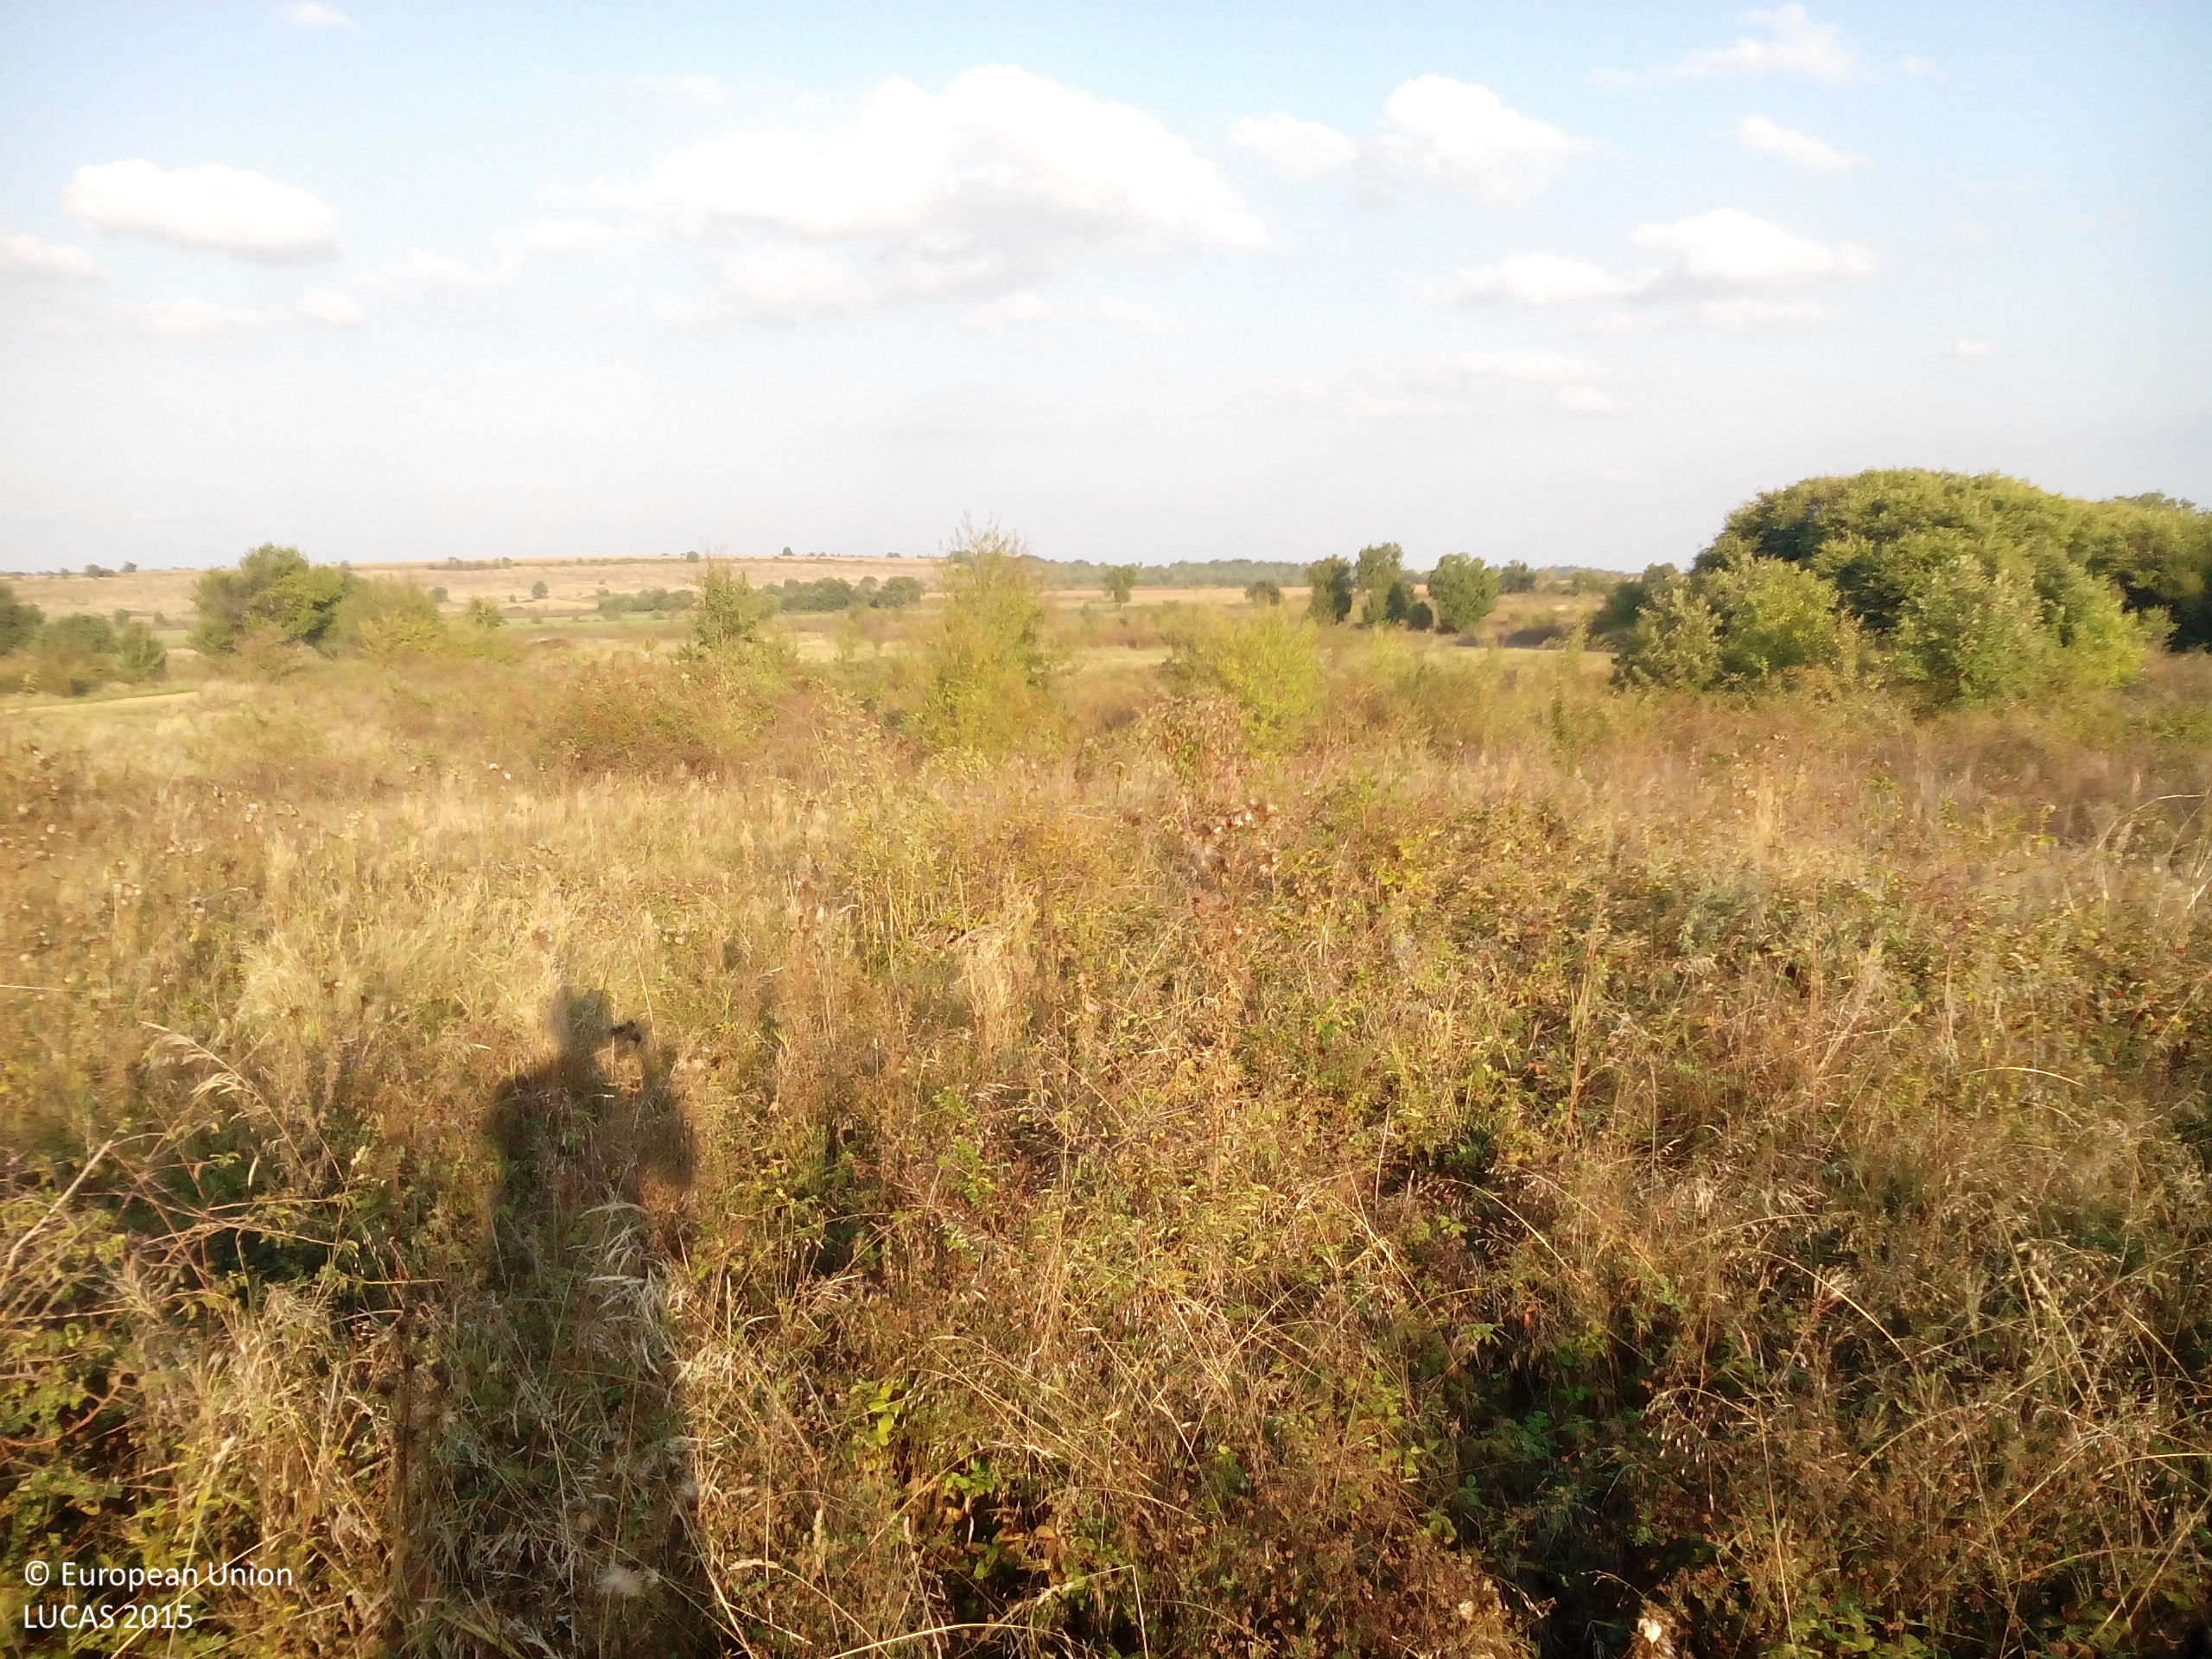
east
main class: Grassland
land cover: Grassland without tree/shrub cover
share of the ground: > 75 %
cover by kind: herbaceous plants 100 %
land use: Abandoned areas
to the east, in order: Grassland without tree/shrub cover; Shrubland with sparse tree cover; Grassland without tree/shrub cover; Shrubland with sparse tree cover; Grassland without tree/shrub cover; Shrubland without tree cover
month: October
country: BG
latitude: 43.2591
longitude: 23.9324
